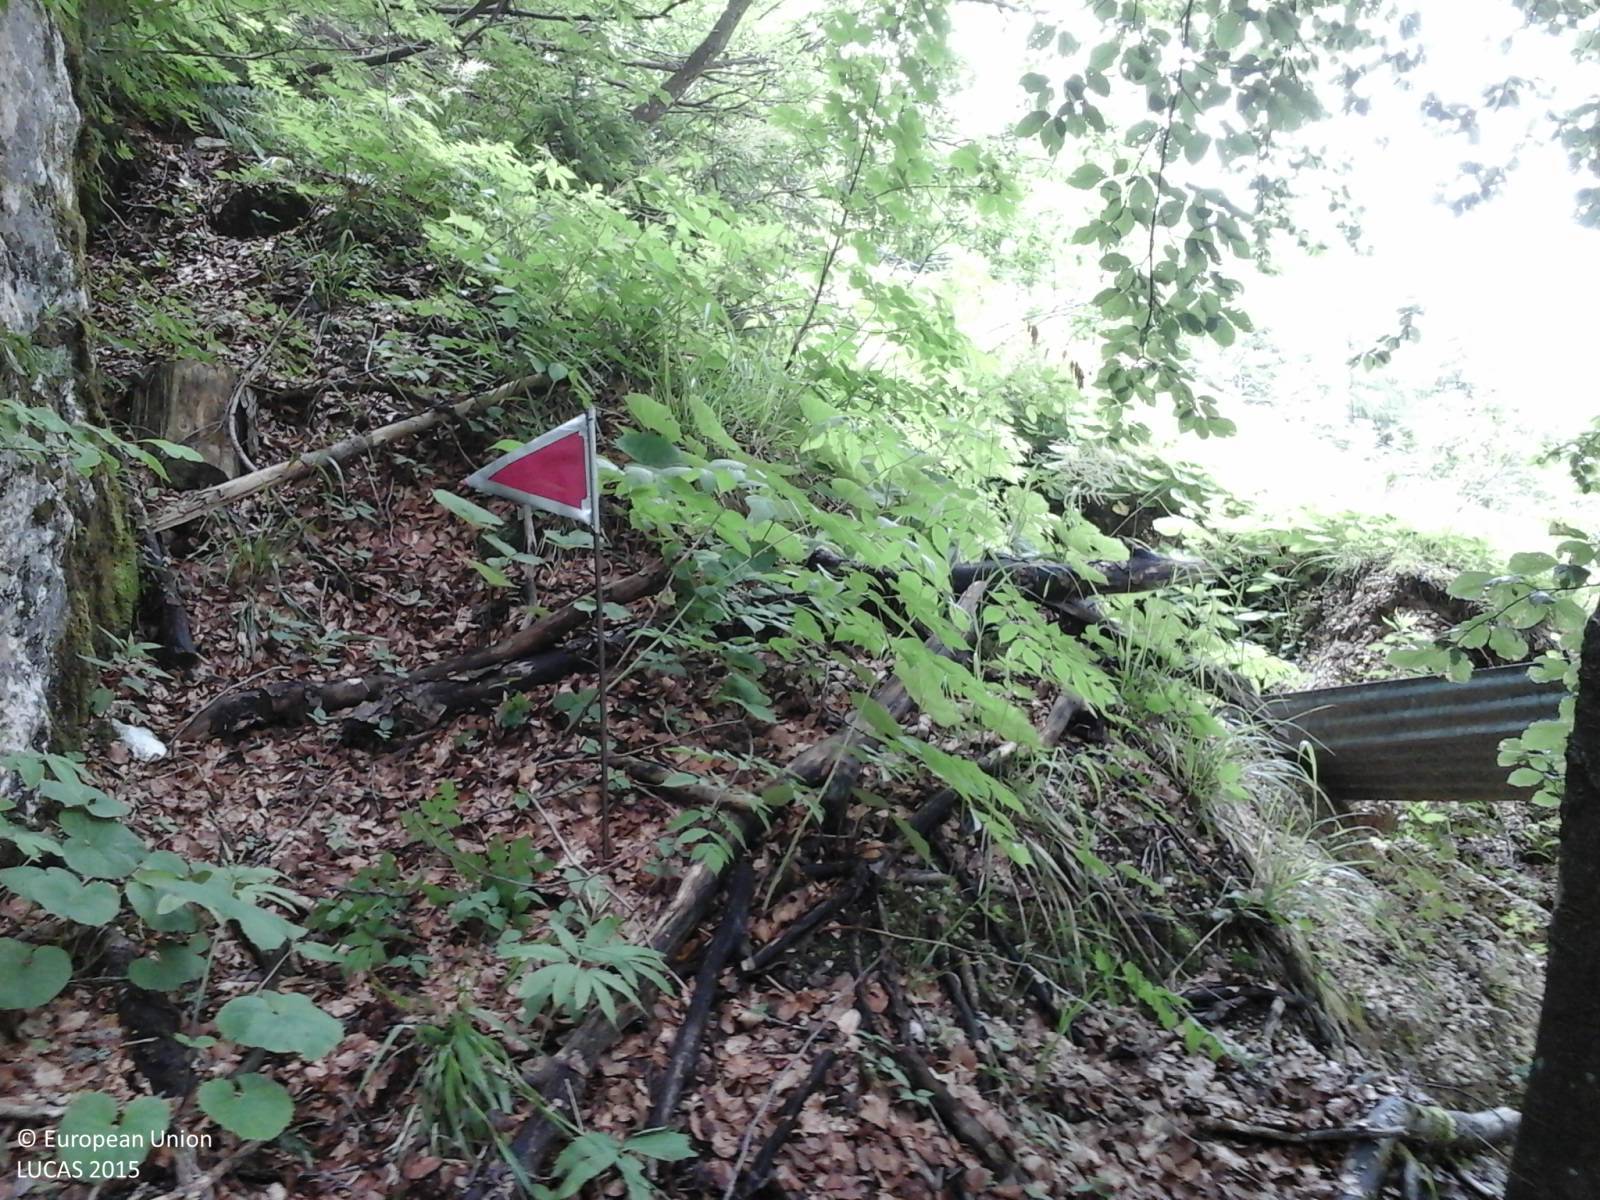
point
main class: Woodland
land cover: Other mixed woodland
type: alpine coniferous forest
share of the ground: > 75 %
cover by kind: coniferous forest trees 50 %, broadleaved forest trees 50 %
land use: Semi-natural and natural areas not in use
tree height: > 5 m
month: June
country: IT
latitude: 46.3851
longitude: 13.4686
